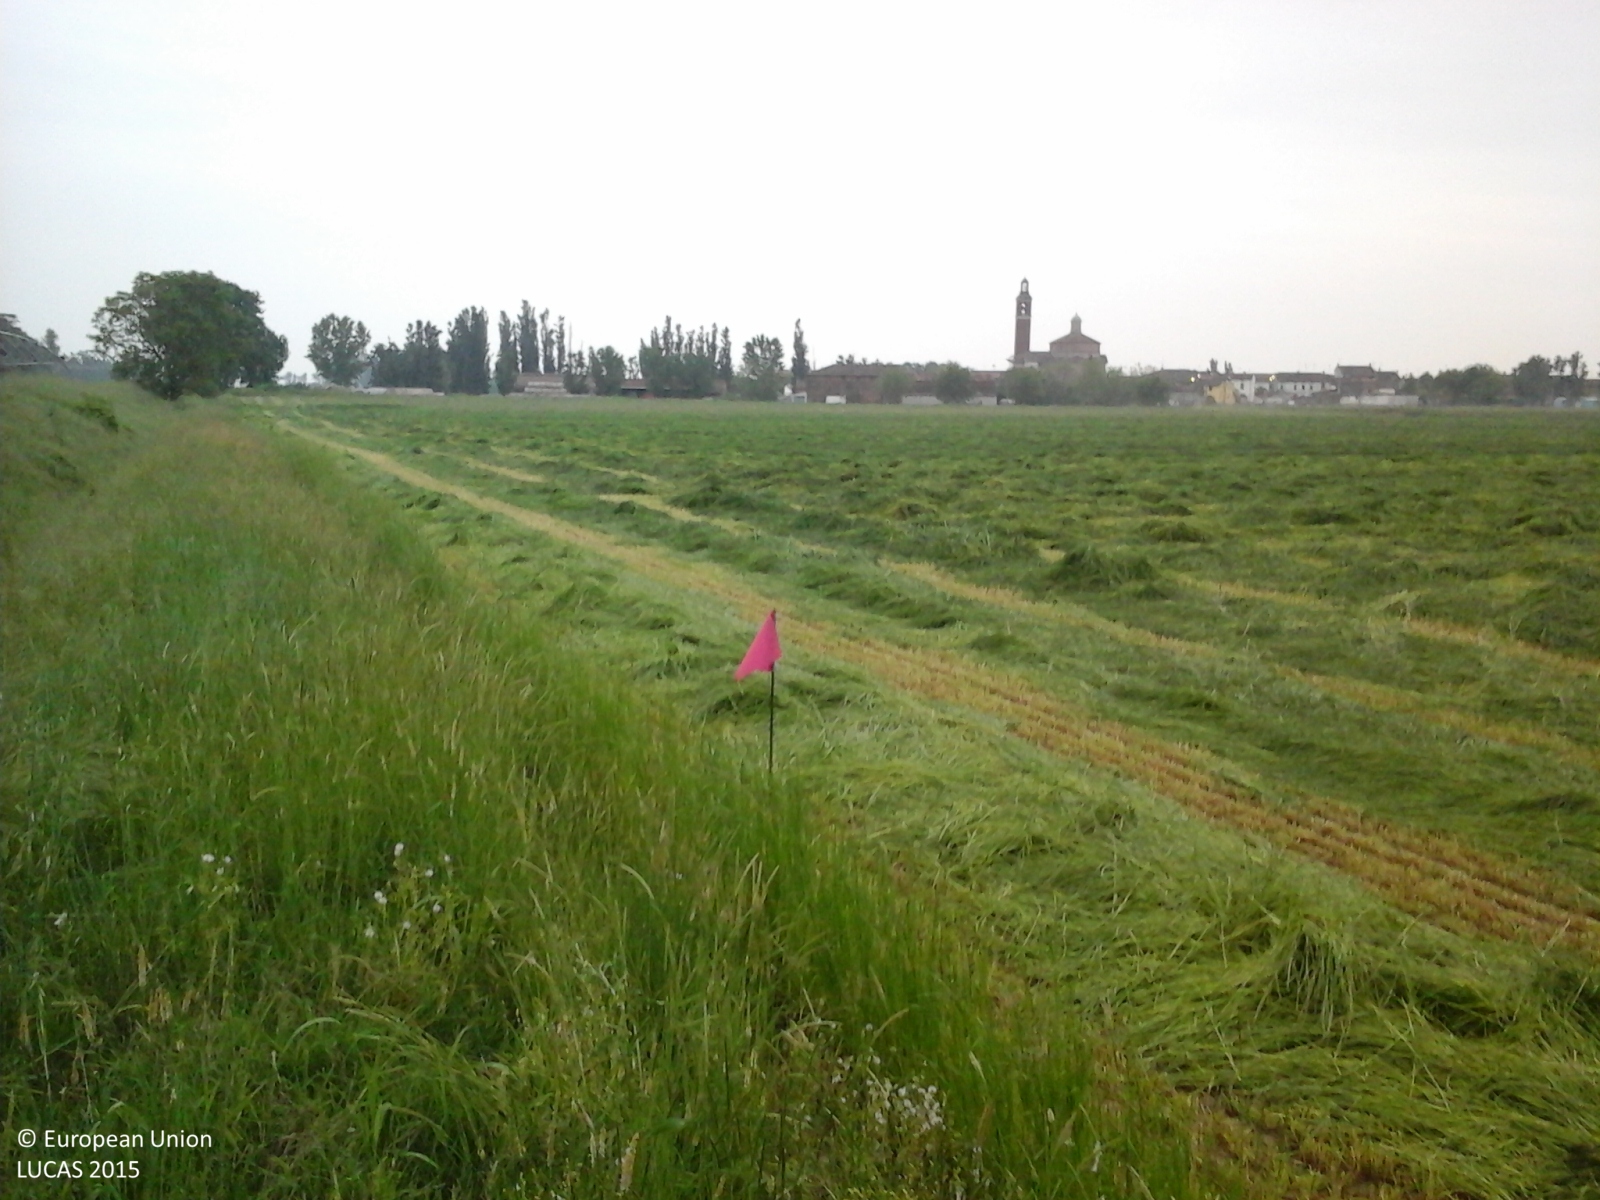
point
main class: Cropland
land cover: Temporary grasslands
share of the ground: > 75 %
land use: Agriculture (excluding fallow land and kitchen gardens)
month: May
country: IT
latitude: 45.0707
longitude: 10.4944
